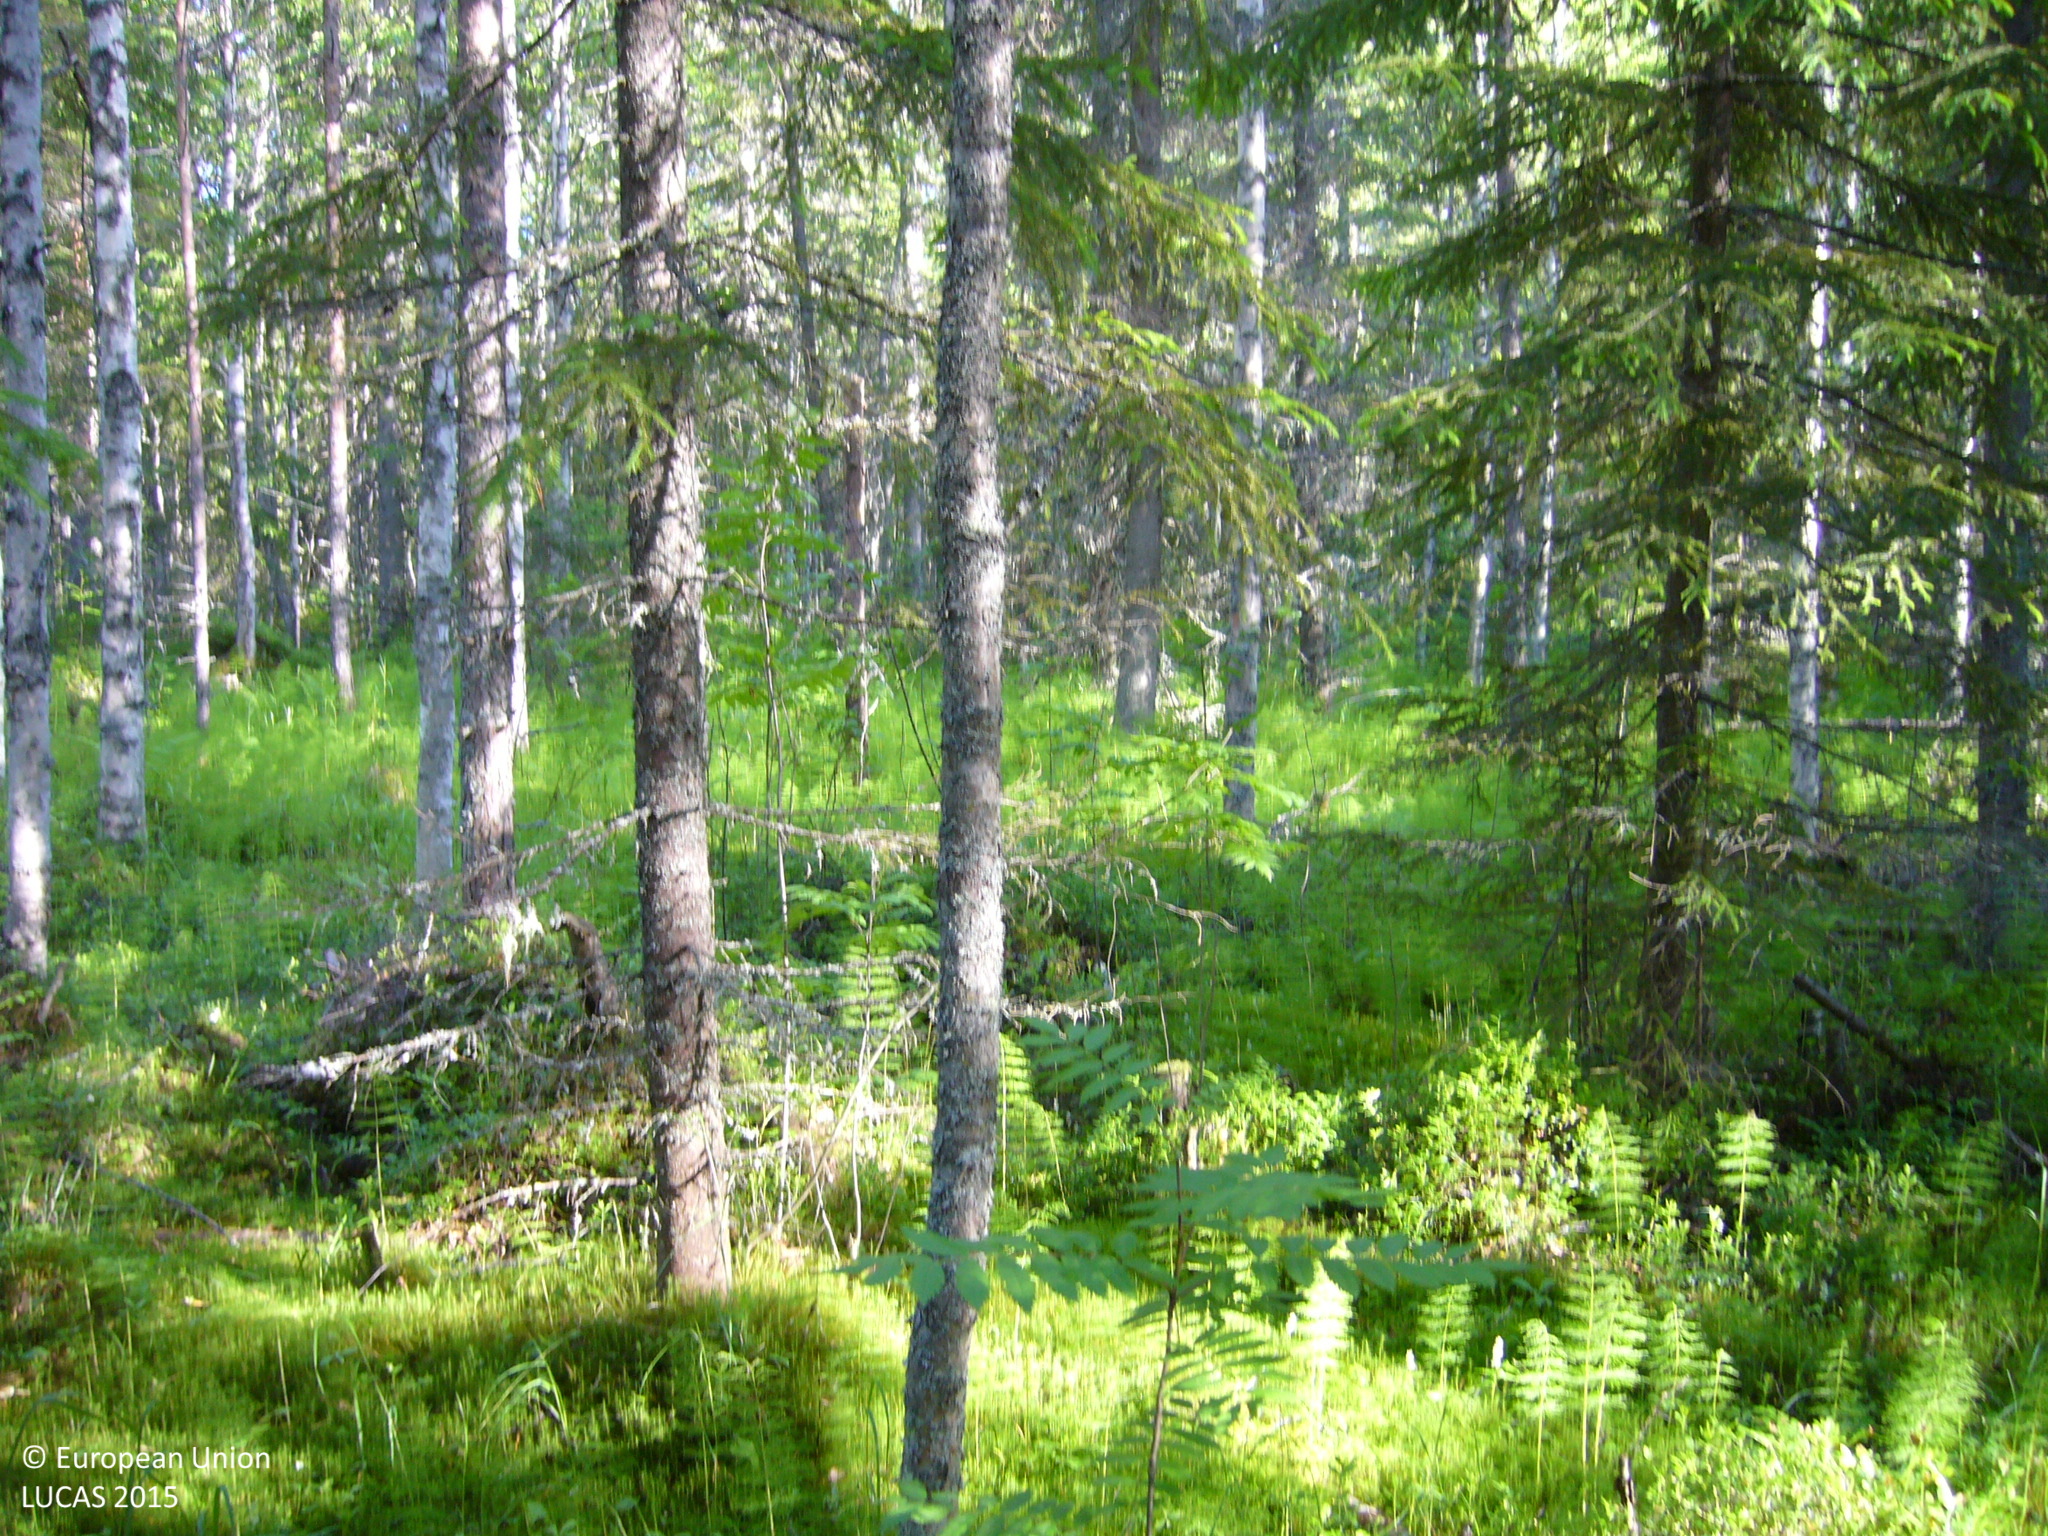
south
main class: Woodland
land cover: Spruce dominated mixed woodland
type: boreal forest
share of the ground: > 75 %
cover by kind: coniferous forest trees 50 %, broadleaved forest trees 40 %, shrubs 10 %
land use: Forestry
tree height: > 5 m
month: July
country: FI
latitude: 63.5015
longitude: 26.3751
